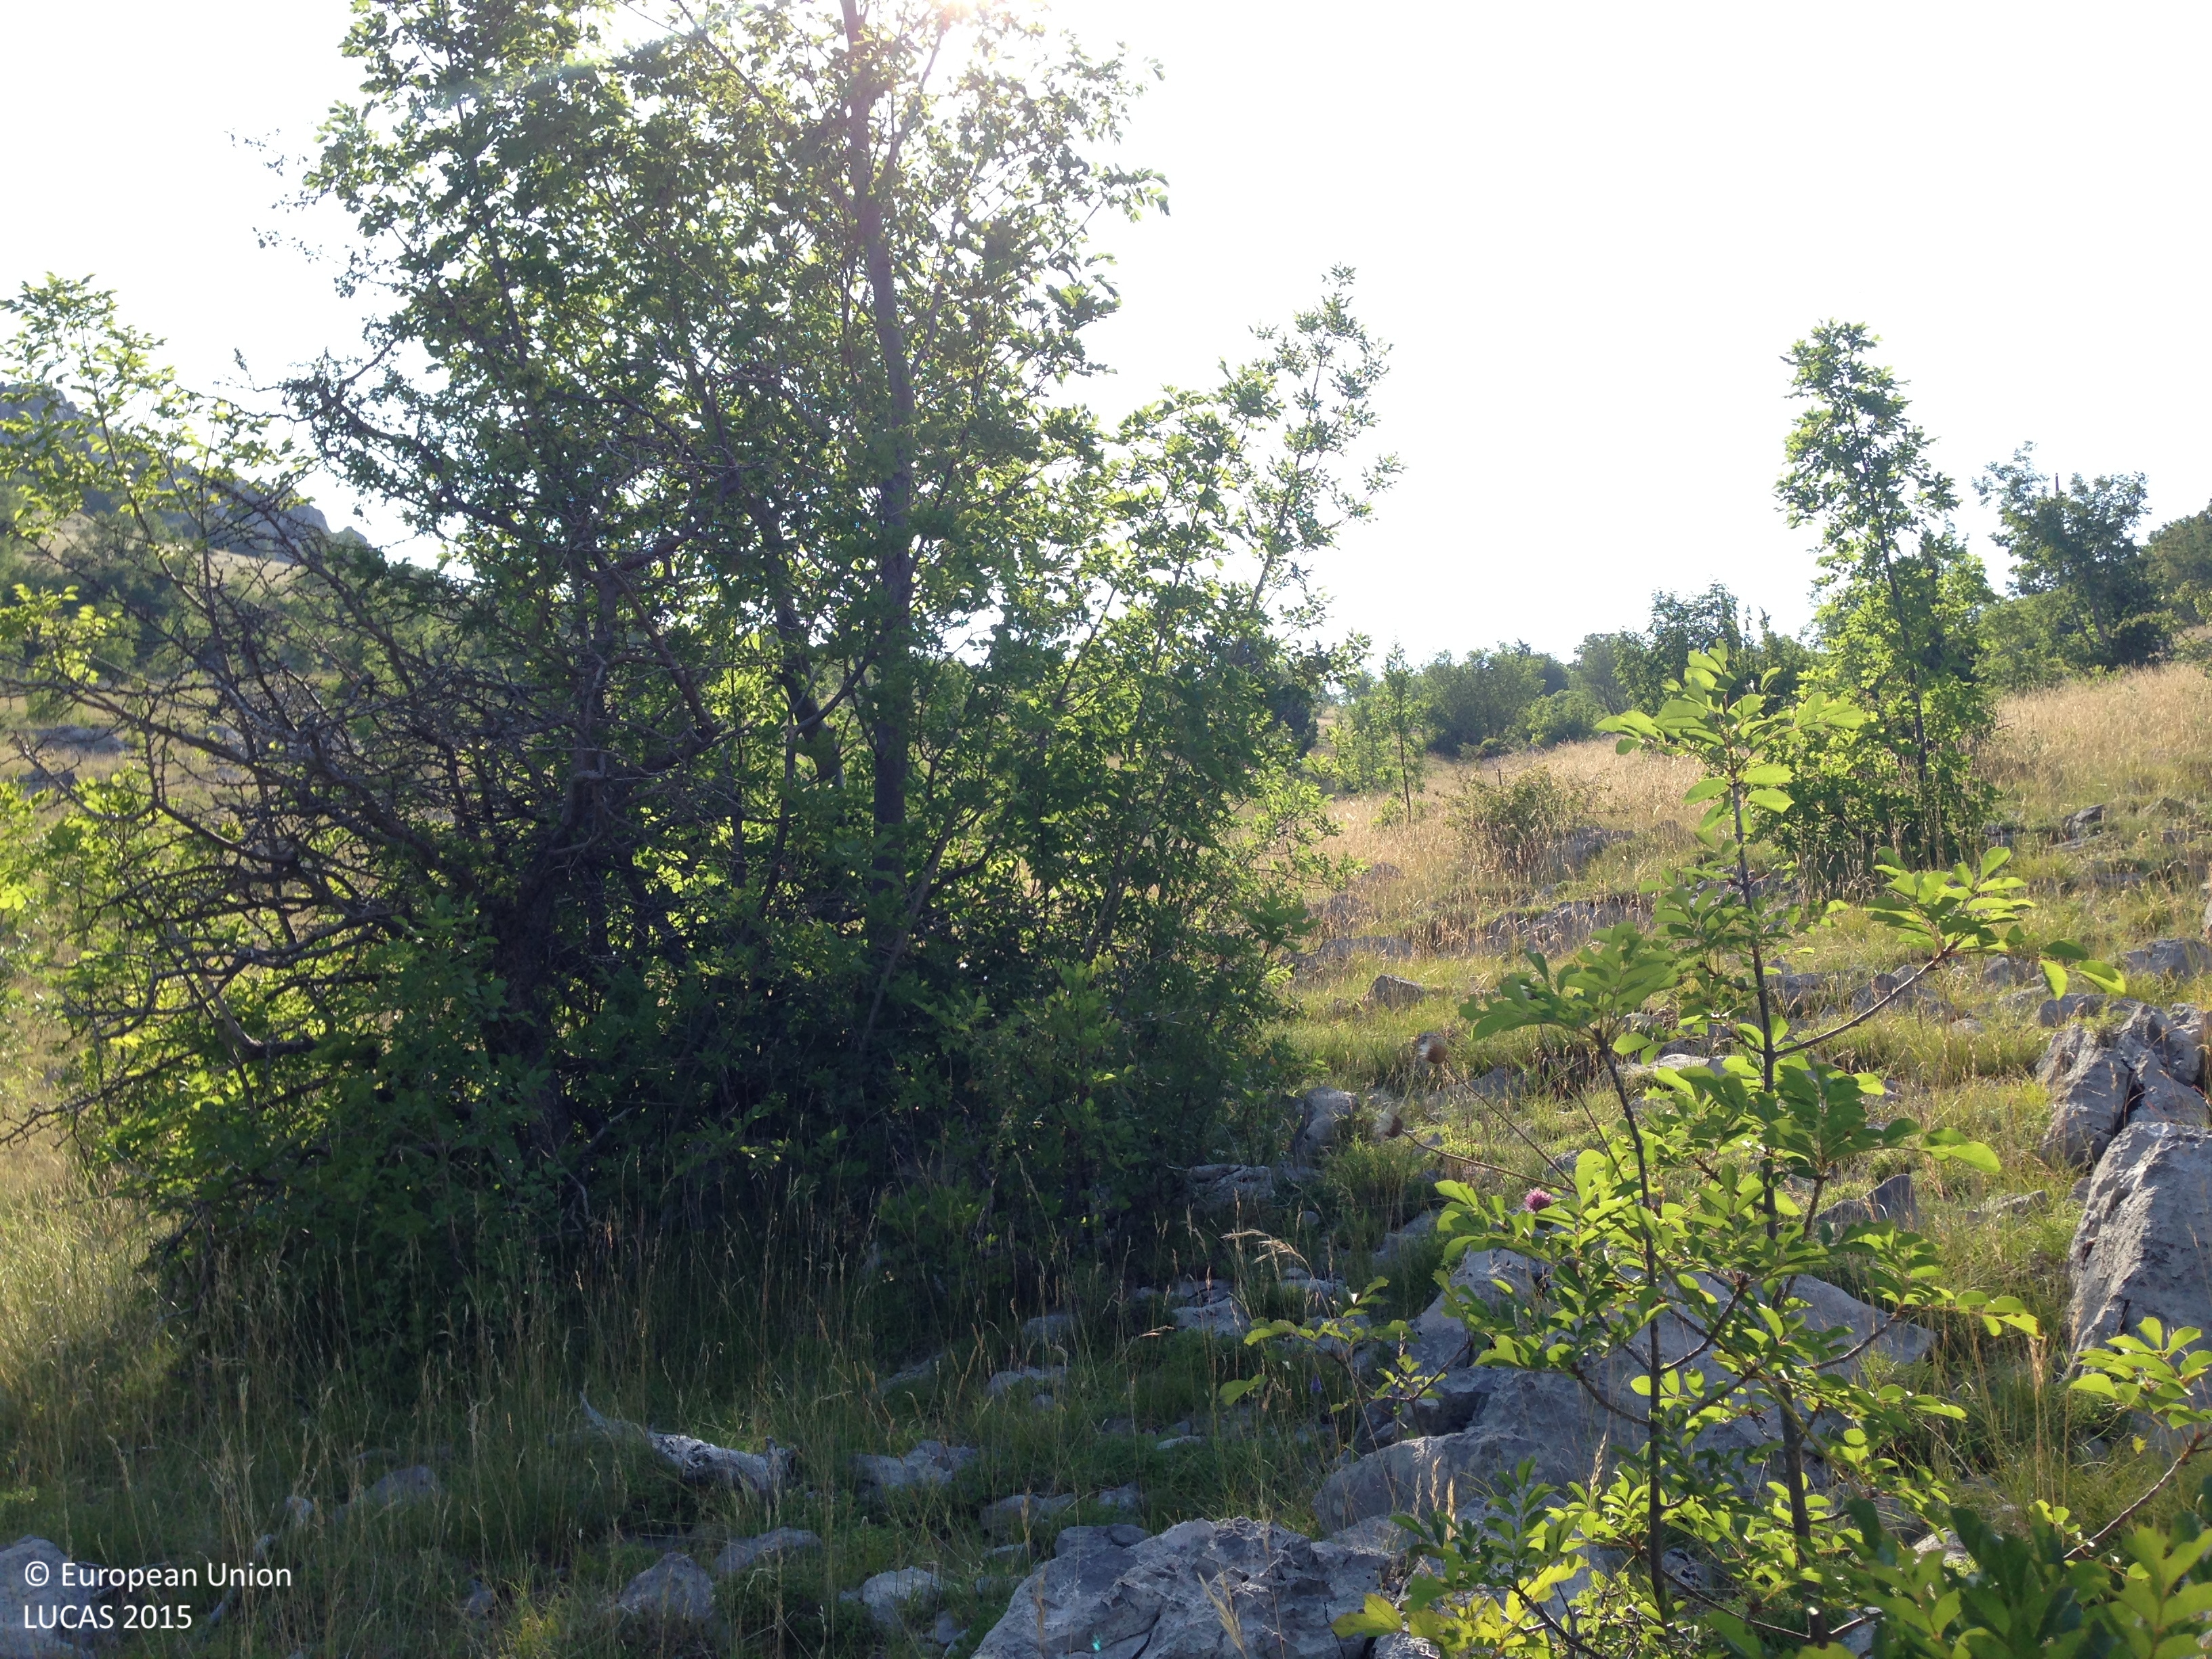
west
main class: Shrubland
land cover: Shrubland with sparse tree cover
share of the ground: 10 - 25 %
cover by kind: herbaceous plants 40 %, shrubs 25 %, consolidated bare surface 15 %, unconsolidated bare surface 15 %, broadleaved forest trees 5 %
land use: Semi-natural and natural areas not in use
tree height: < 5 m
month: July
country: HR
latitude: 44.5124
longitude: 15.1382
